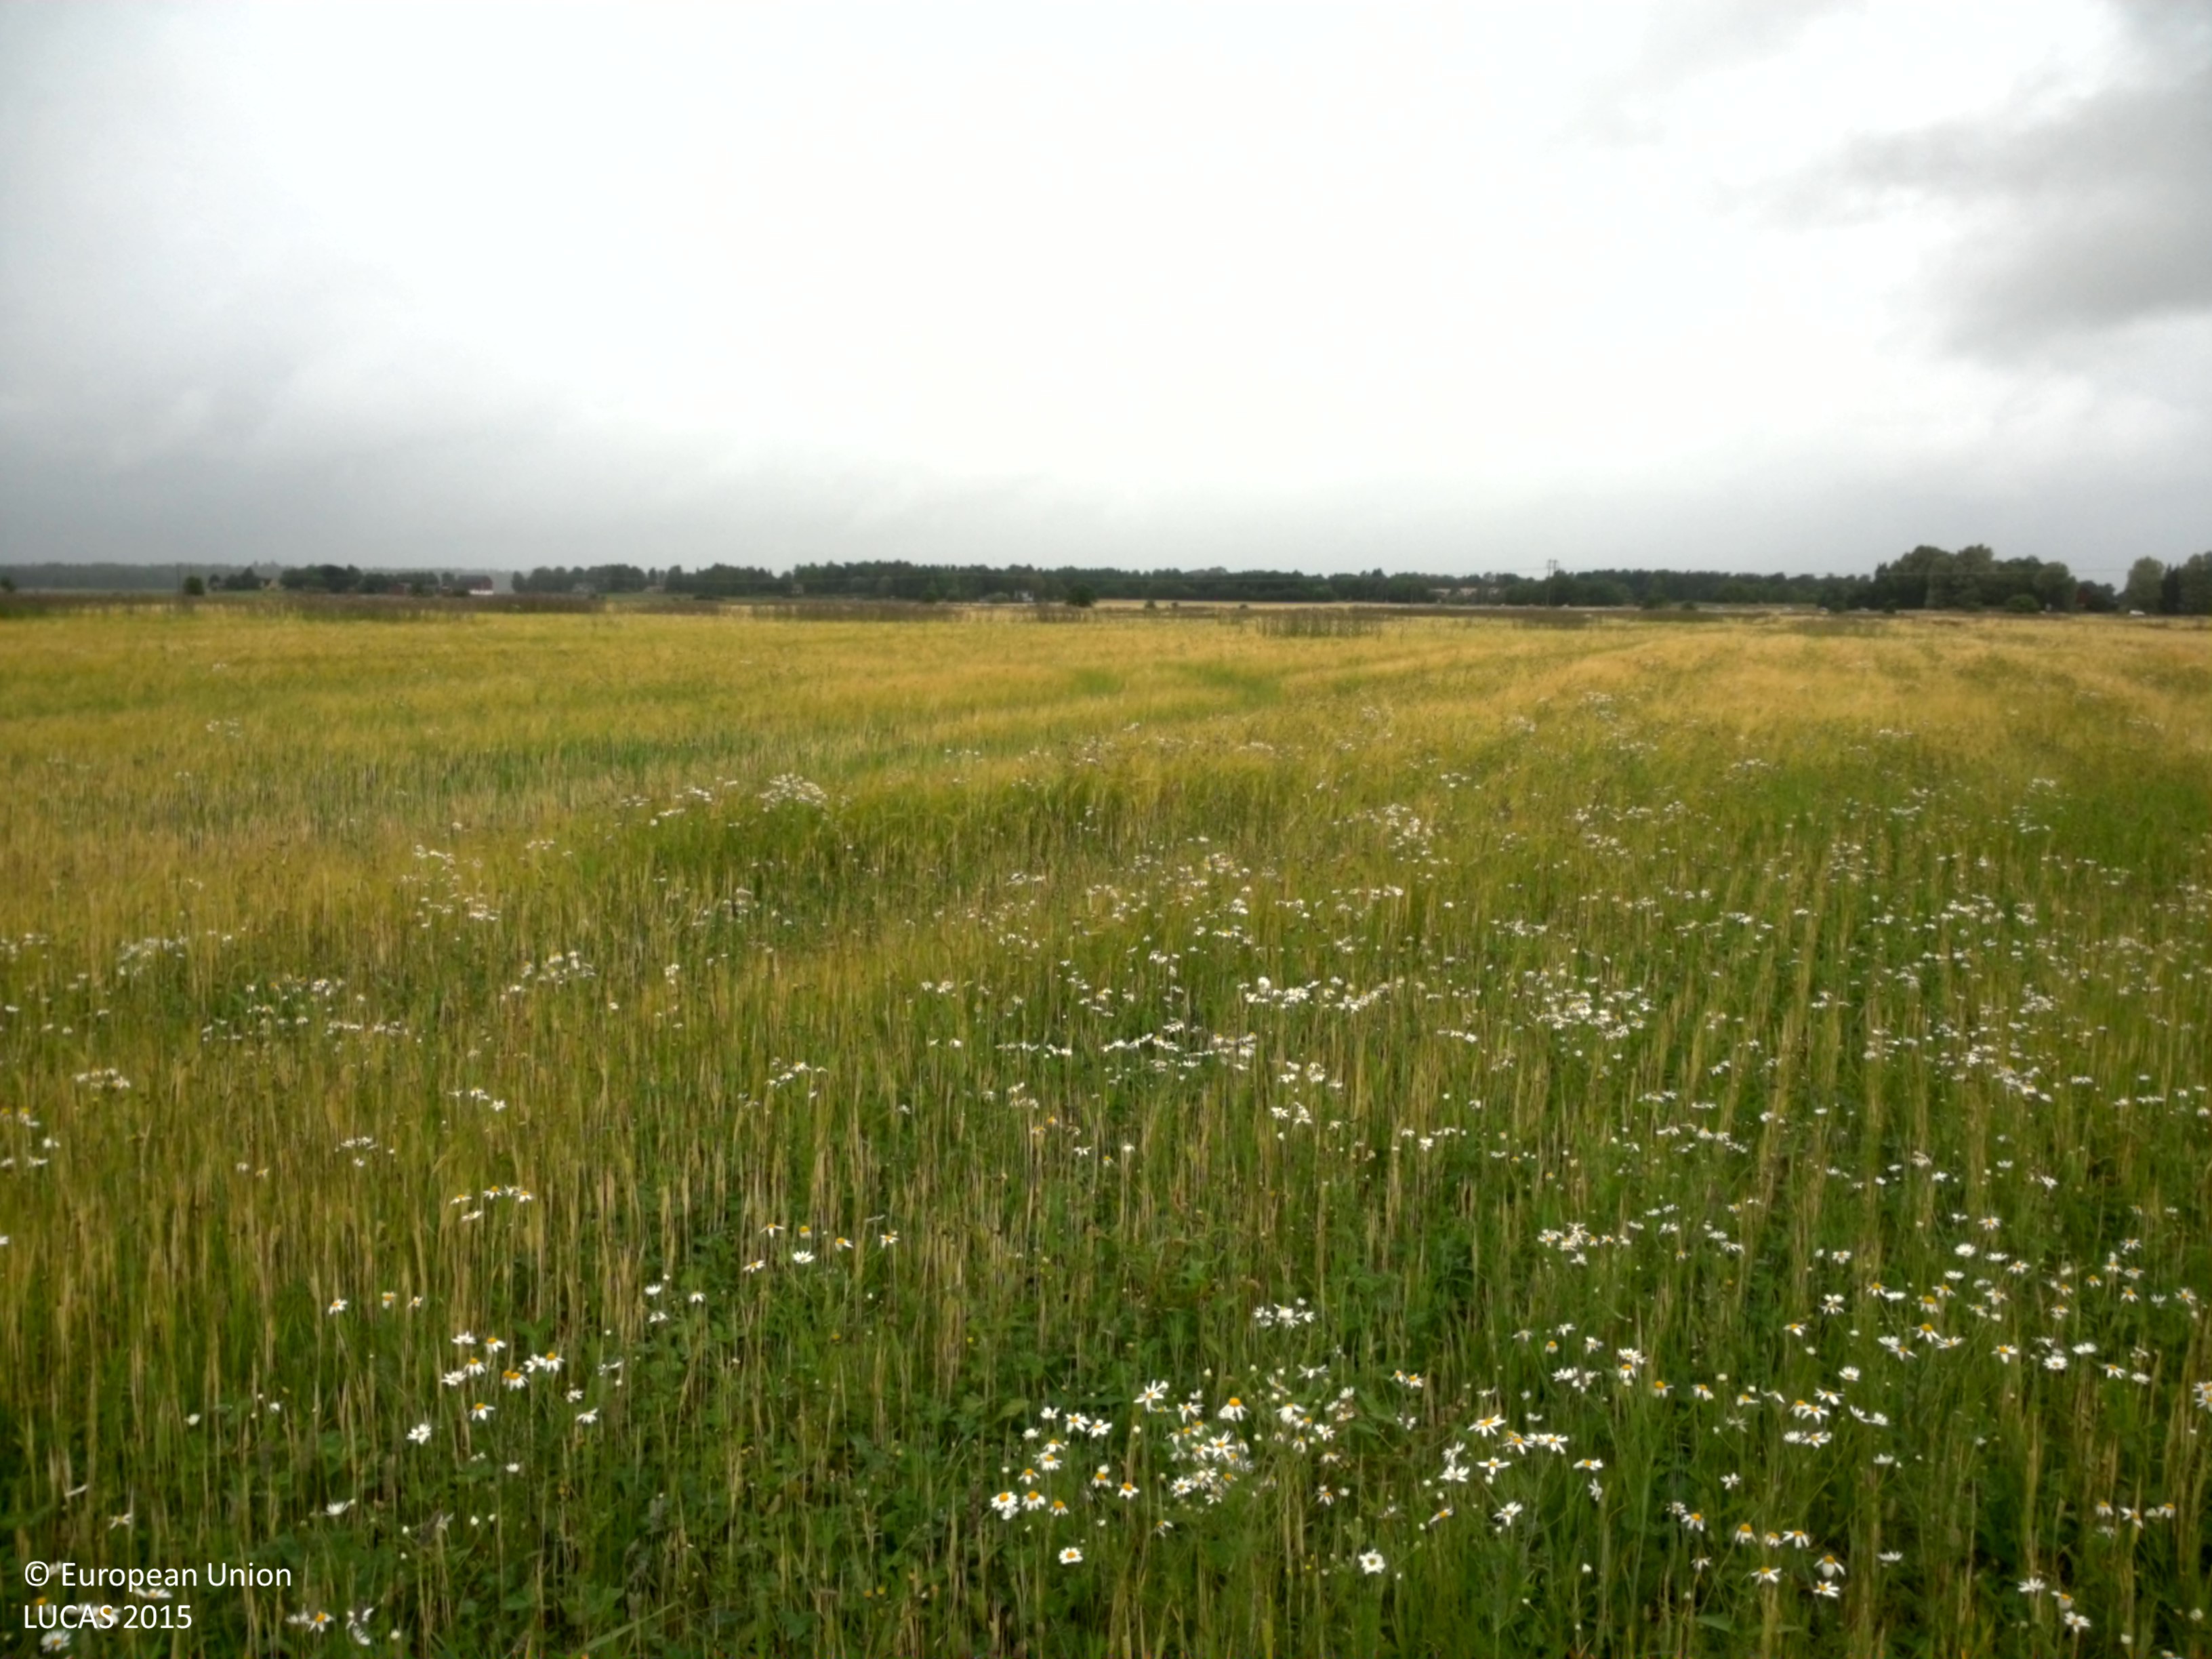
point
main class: Cropland
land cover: Barley
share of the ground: 25 - 50 %
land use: Agriculture (excluding fallow land and kitchen gardens)
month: July
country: SE
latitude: 58.7379
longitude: 13.9493
